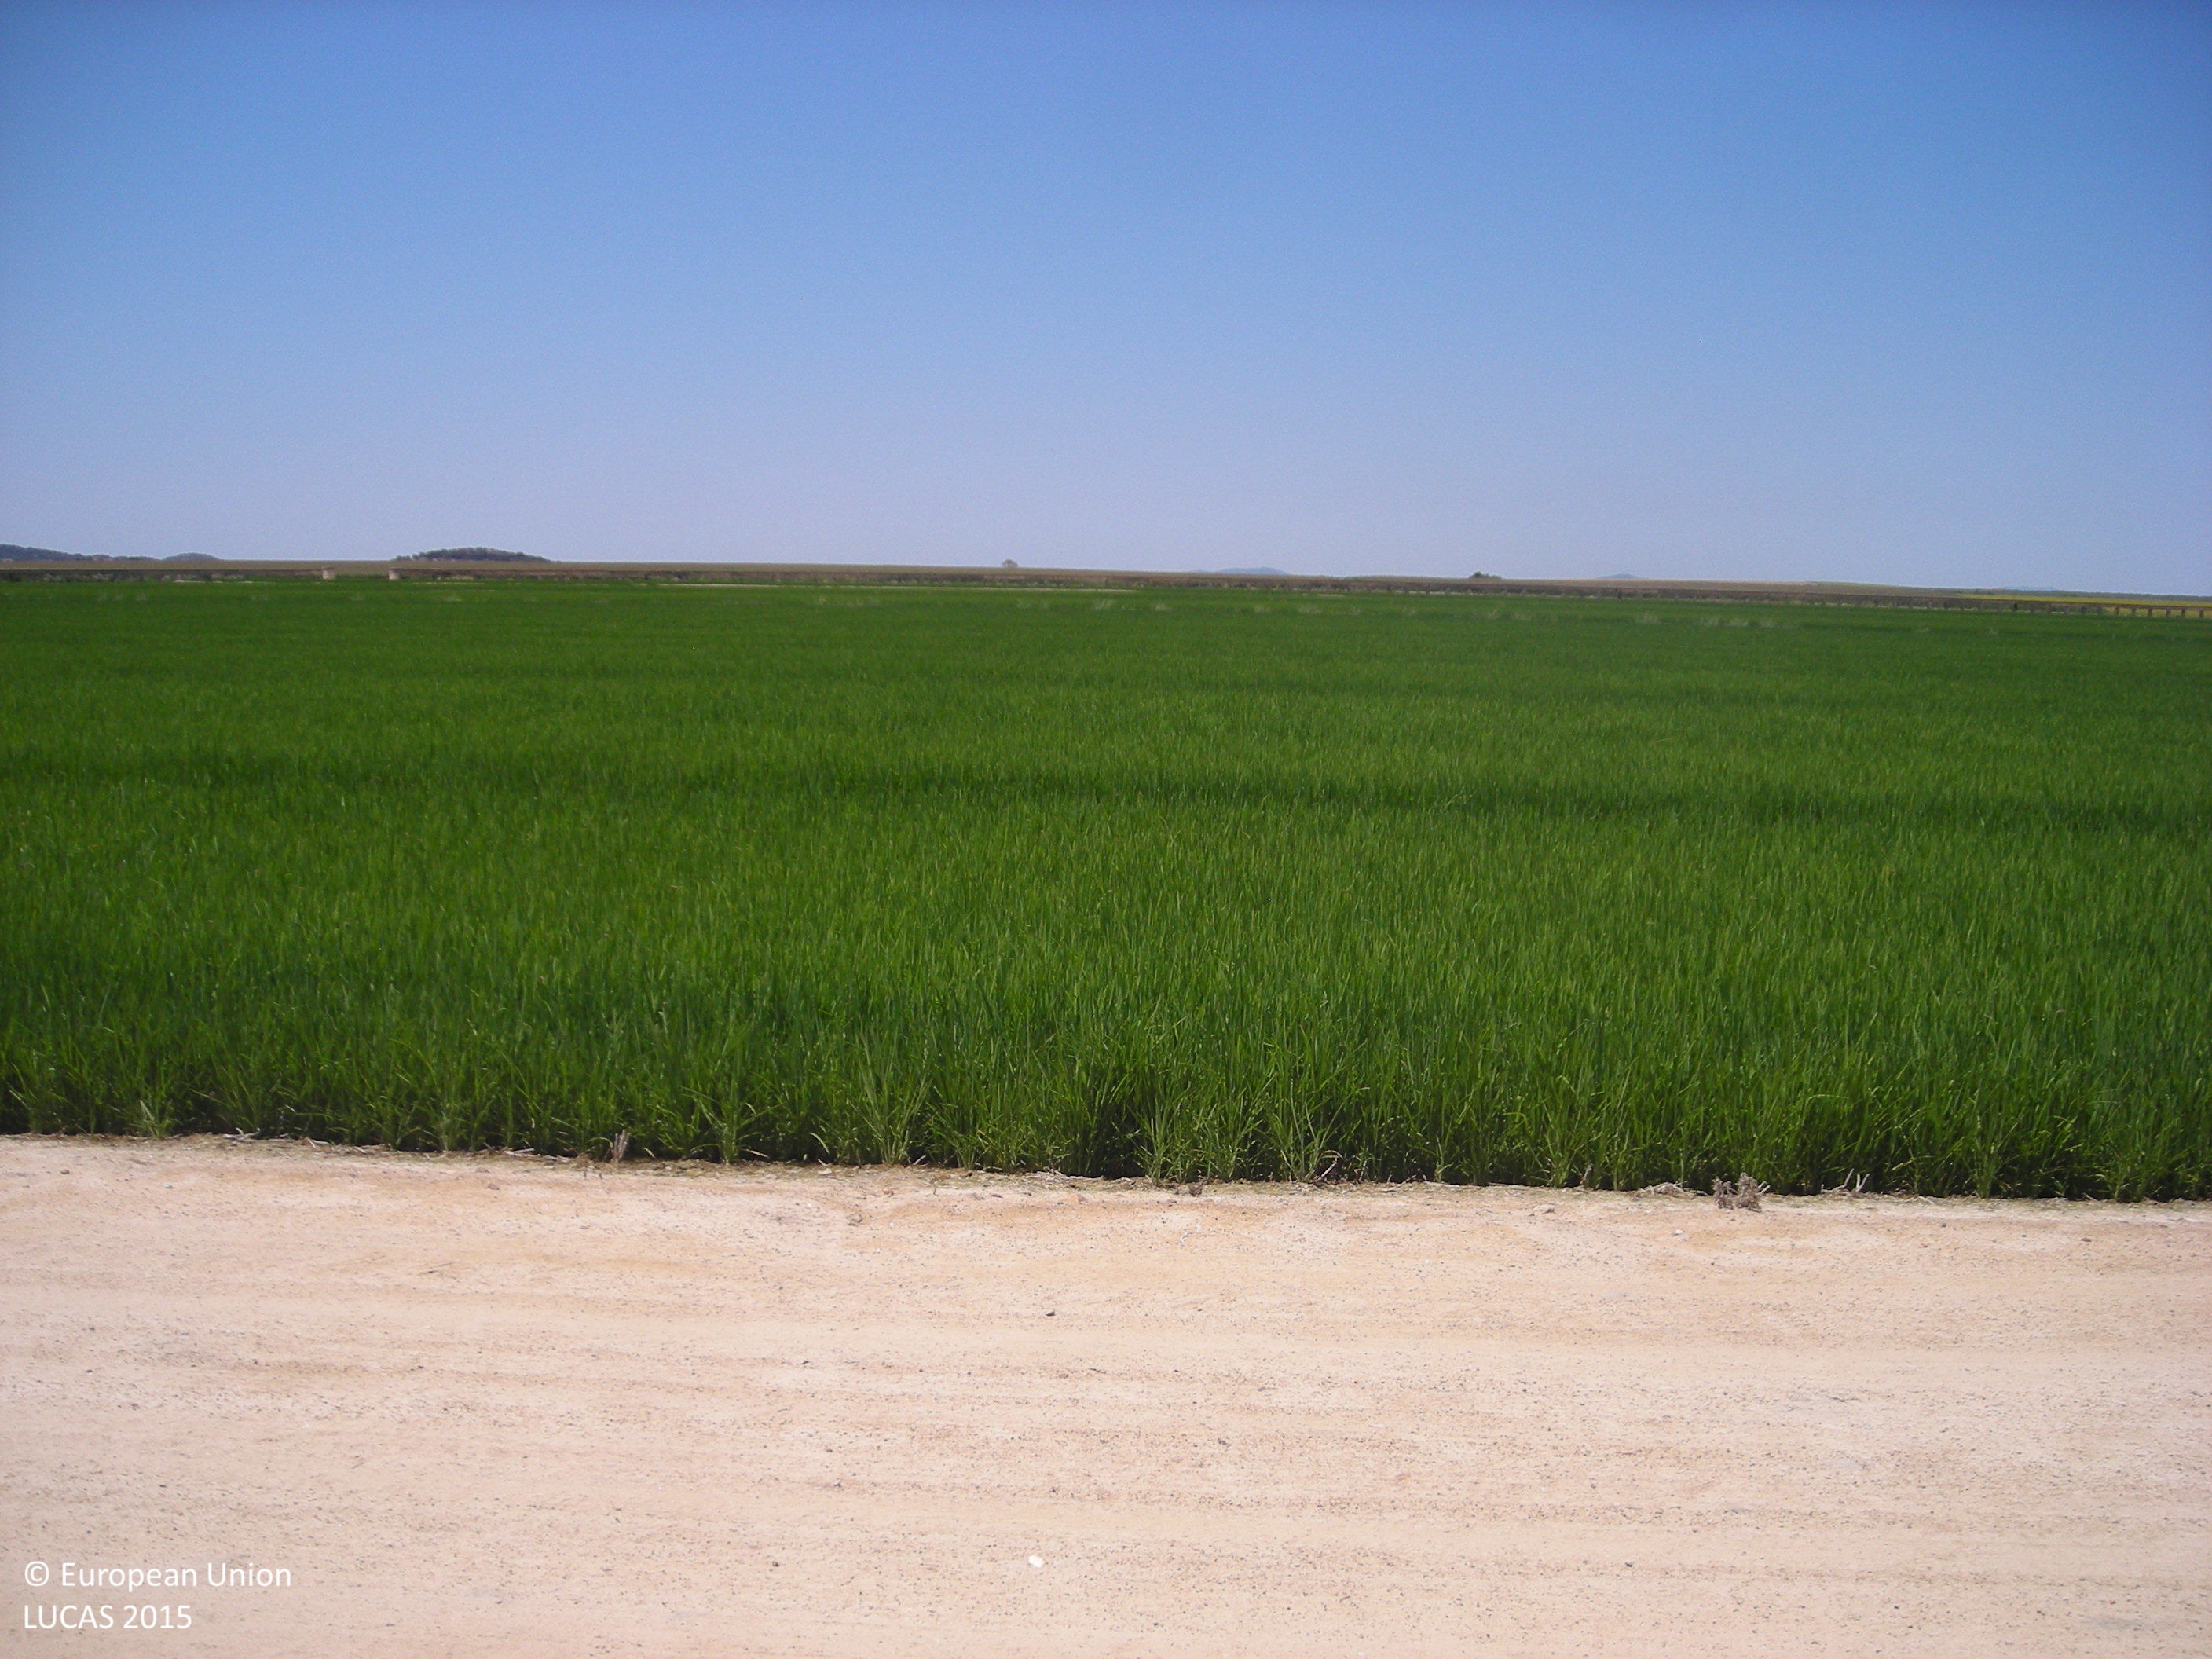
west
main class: Cropland
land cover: Rice
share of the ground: > 75 %
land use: Agriculture (excluding fallow land and kitchen gardens)
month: July
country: ES
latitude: 39.1047
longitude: -5.8124
